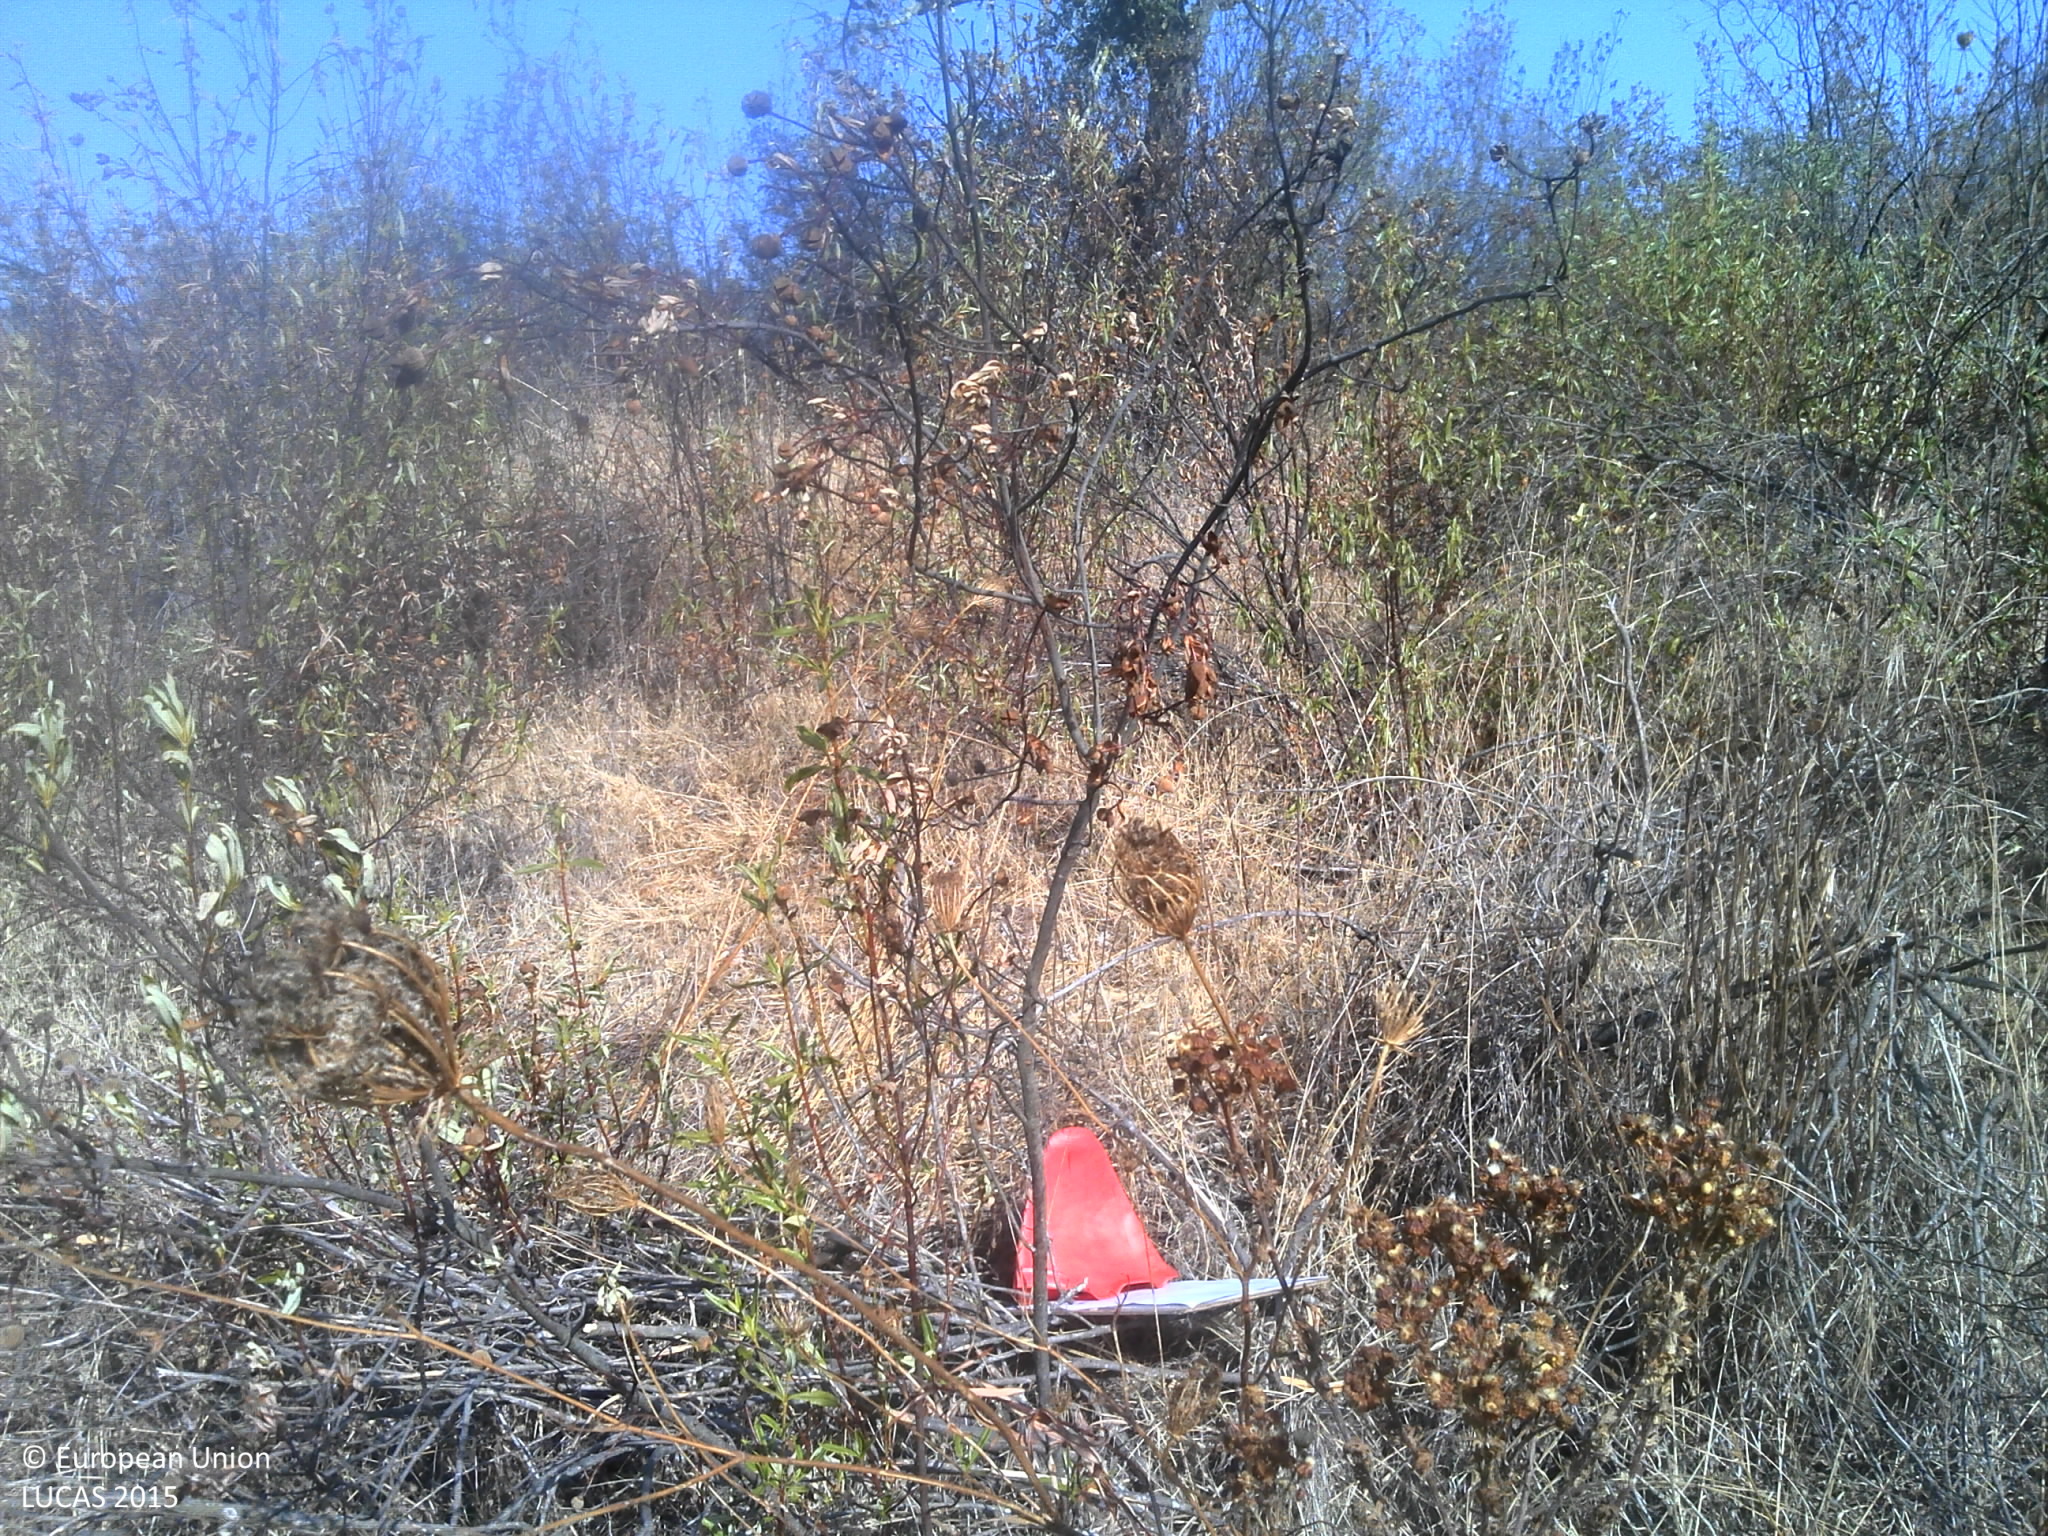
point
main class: Shrubland
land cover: Shrubland with sparse tree cover
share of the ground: 50 - 75 %
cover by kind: shrubs 65 %, herbaceous plants 20 %, unconsolidated bare surface 10 %, broadleaved forest trees 5 %
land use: Forestry
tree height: < 5 m
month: August
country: PT
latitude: 37.5598
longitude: -8.2422
